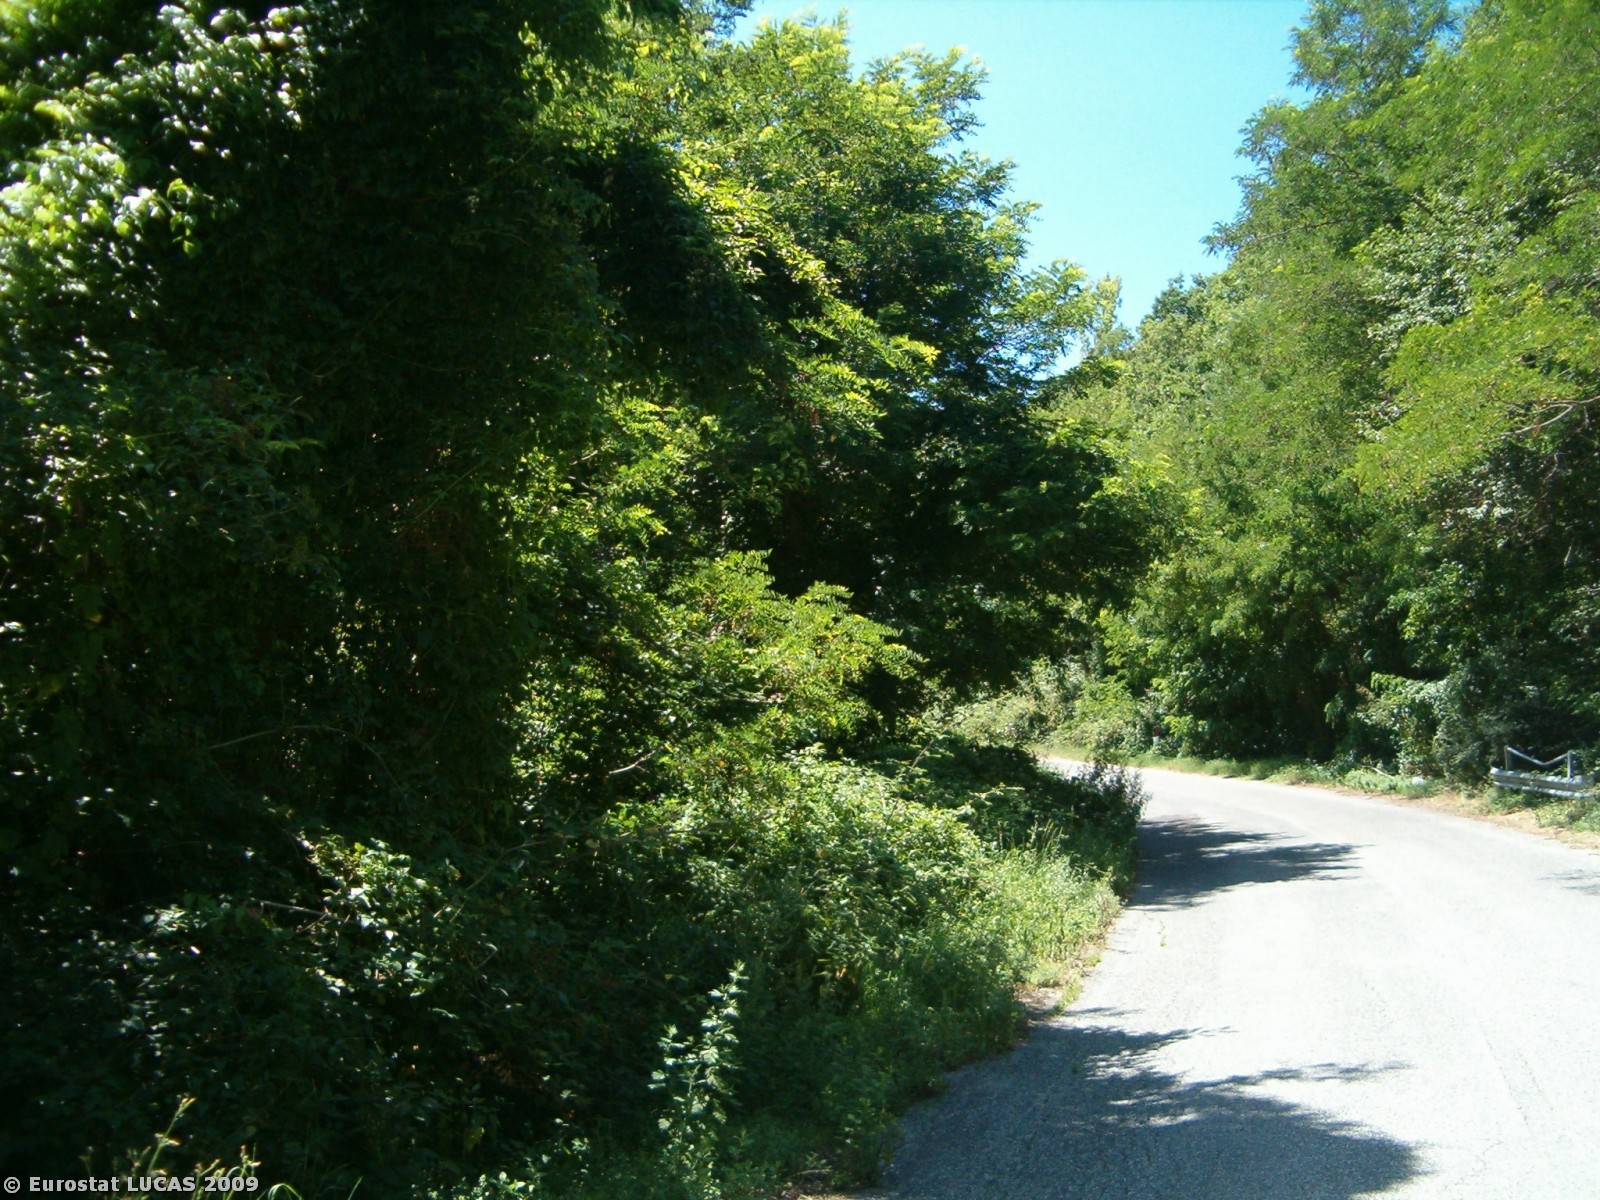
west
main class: Woodland
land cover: Broadleaved woodland
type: thermophilous deciduous forest
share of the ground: > 75 %
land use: Forestry
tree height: > 5 m
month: July
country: IT
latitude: 42.4036
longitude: 13.2336
